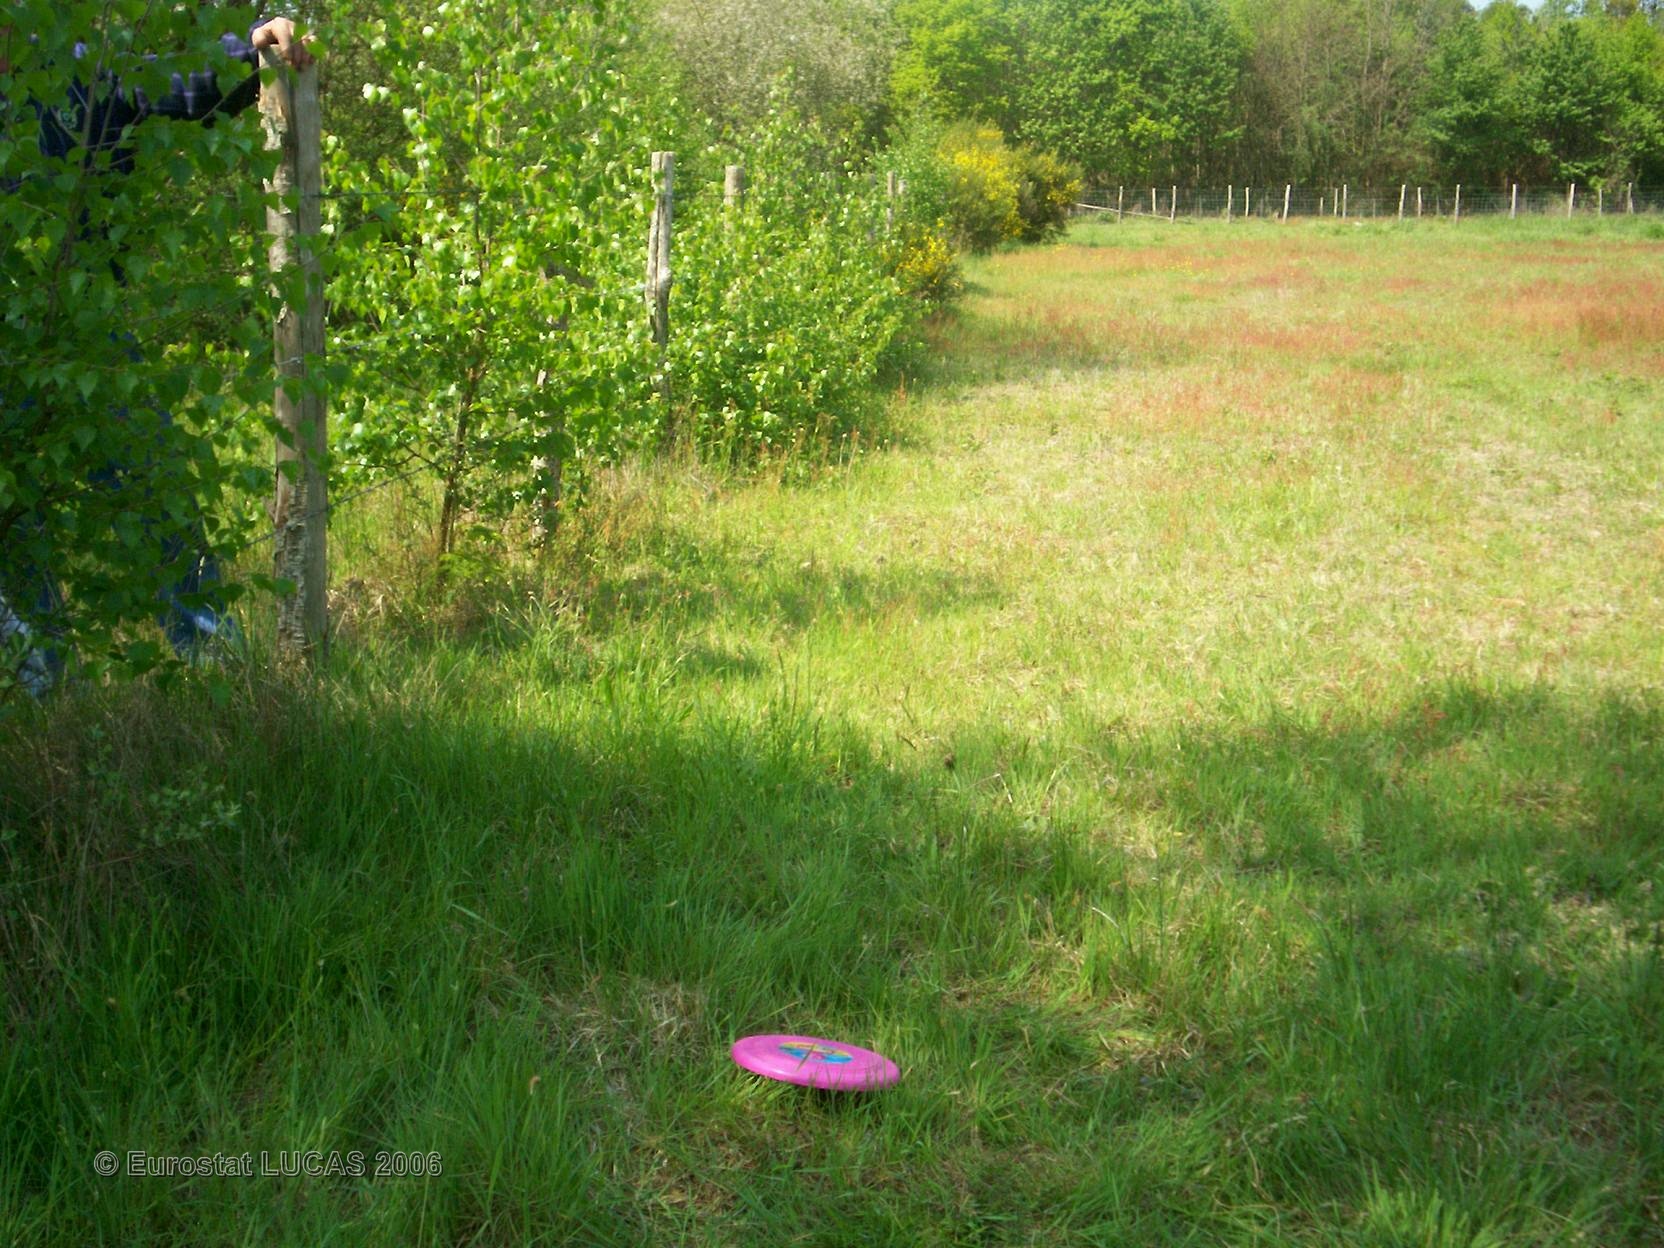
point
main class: Grassland
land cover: Grassland without tree/shrub cover
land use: Agriculture (excluding fallow land and kitchen gardens)
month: May
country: FR
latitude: 47.7673
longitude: 0.1945
